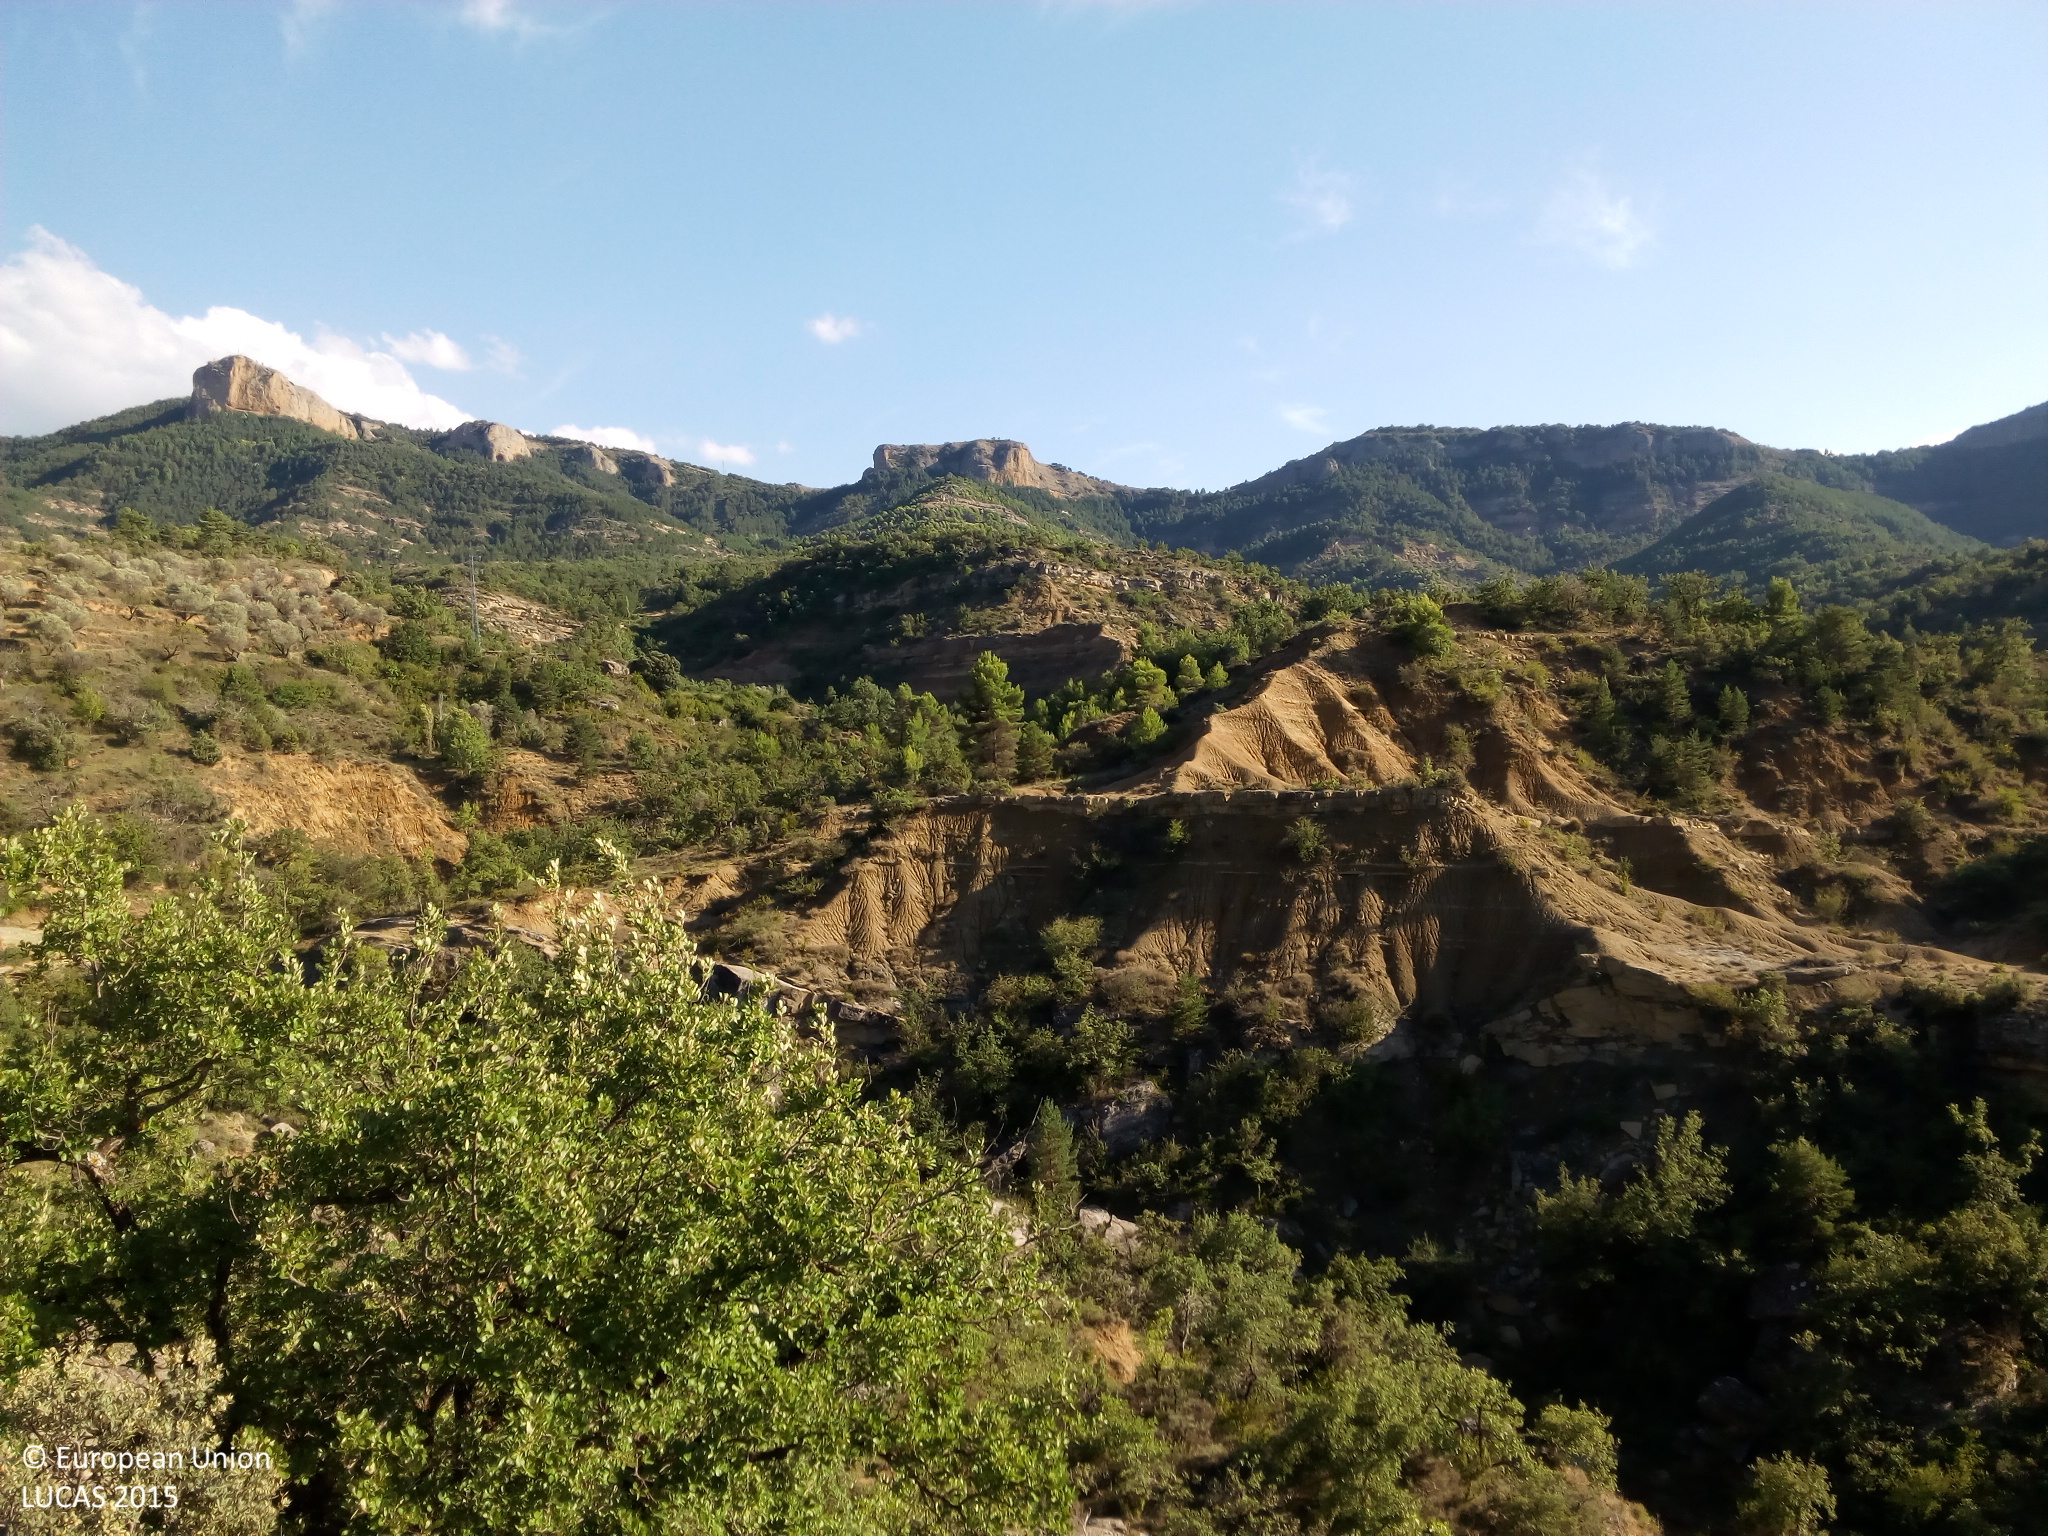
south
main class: Shrubland
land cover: Shrubland with sparse tree cover
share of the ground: > 75 %
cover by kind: consolidated bare surface 50 %, unconsolidated bare surface 30 %, shrubs 15 %, broadleaved forest trees 5 %
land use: Semi-natural and natural areas not in use
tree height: < 5 m
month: August
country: ES
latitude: 42.1840
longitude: 0.4536
